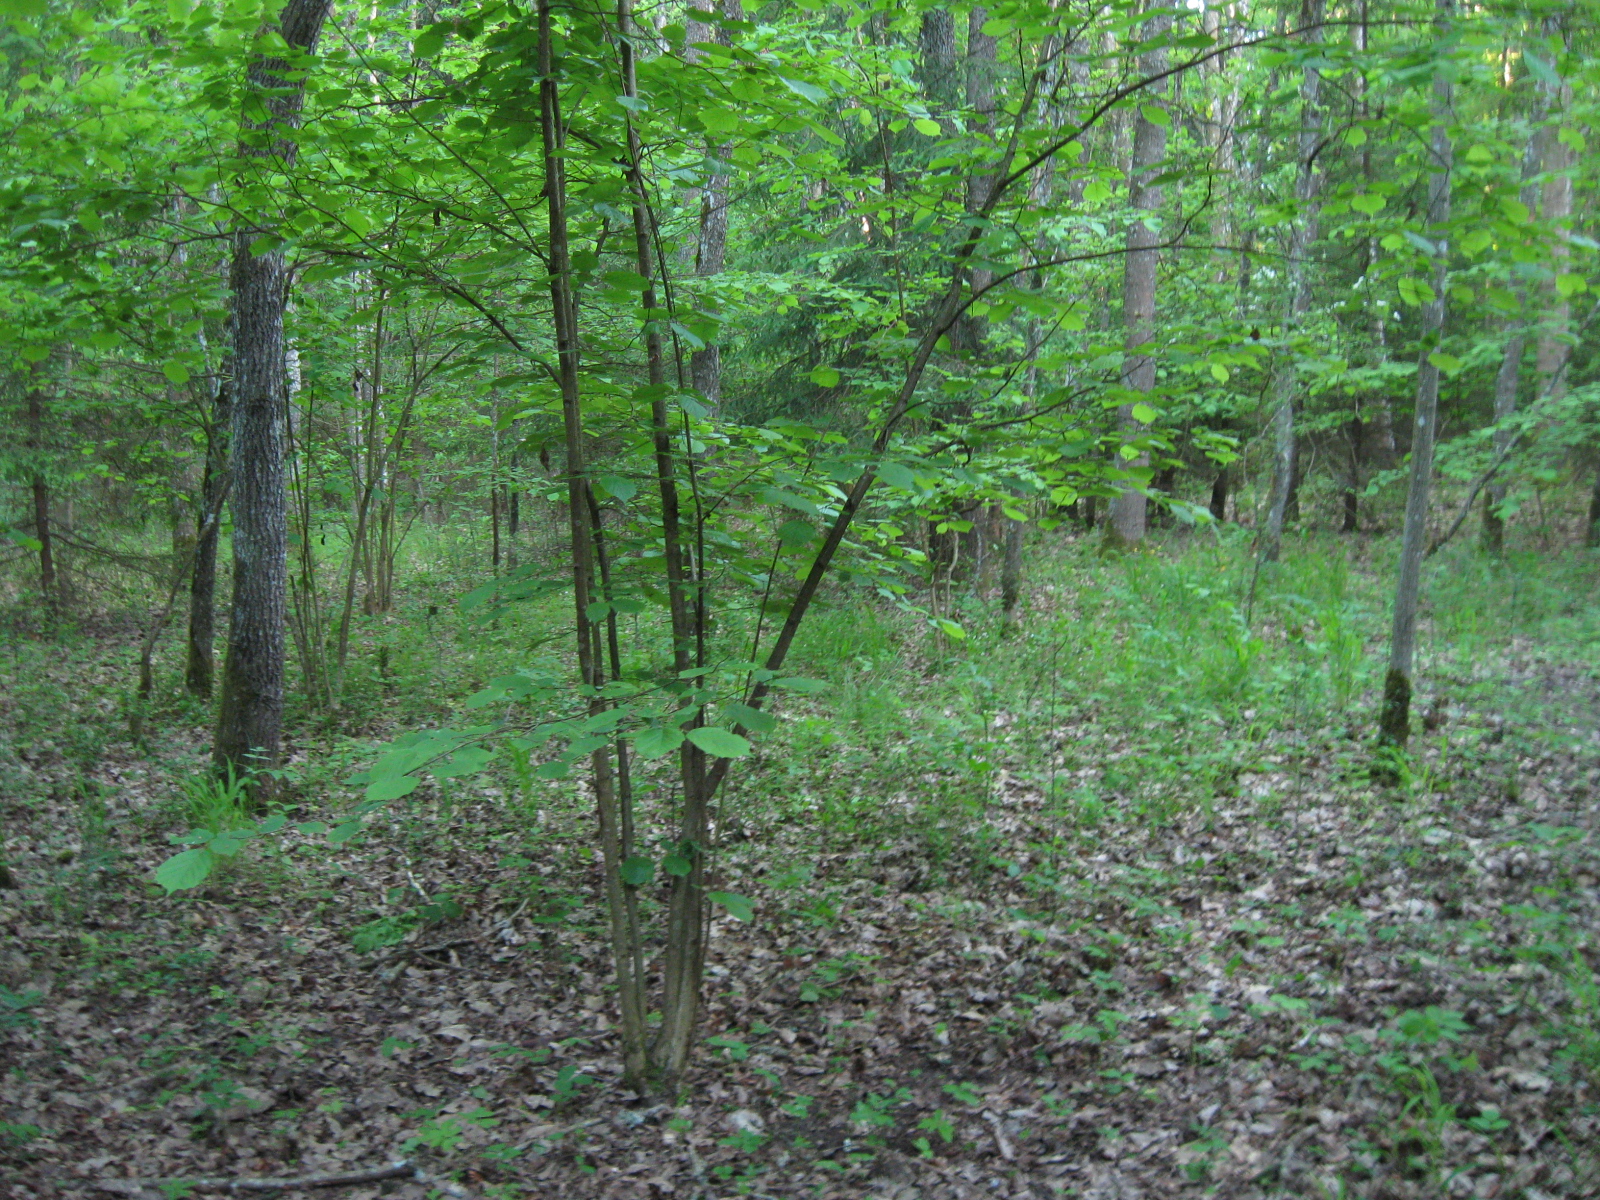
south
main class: Woodland
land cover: Spruce dominated mixed woodland
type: hemiboreal forest and nemoral coniferous forest and mixed broadleaved-coniferous forest
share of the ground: > 75 %
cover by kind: broadleaved forest trees 60 %, coniferous forest trees 40 %
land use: Forestry
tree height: > 5 m
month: June
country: LT
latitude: 54.4548
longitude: 23.9263
